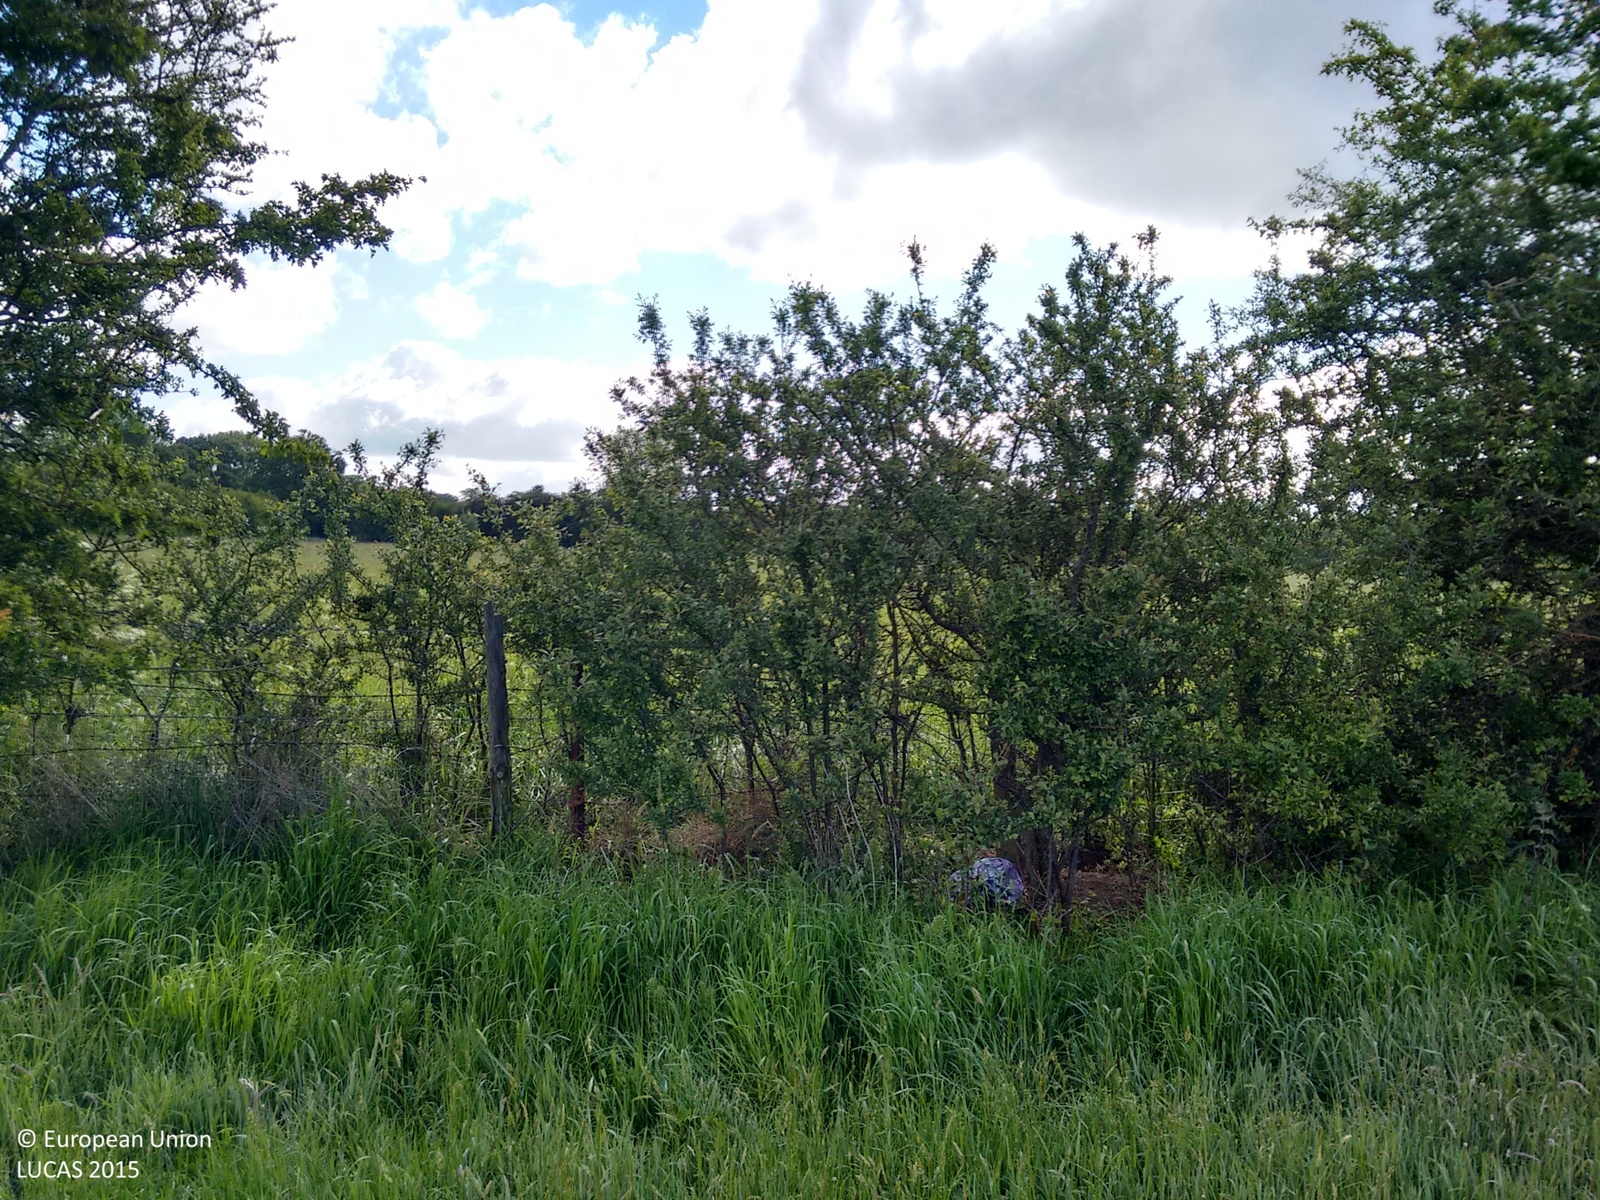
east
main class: Grassland
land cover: Grassland without tree/shrub cover
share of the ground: > 75 %
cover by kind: herbaceous plants 100 %
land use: Agriculture (excluding fallow land and kitchen gardens)
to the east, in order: Grassland without tree/shrub cover; Managed hedges; Fences; Grassland without tree/shrub cover; Managed hedges; Artificial constructions in urban areas
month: June
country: GB
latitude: 54.0802
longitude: -1.1878
